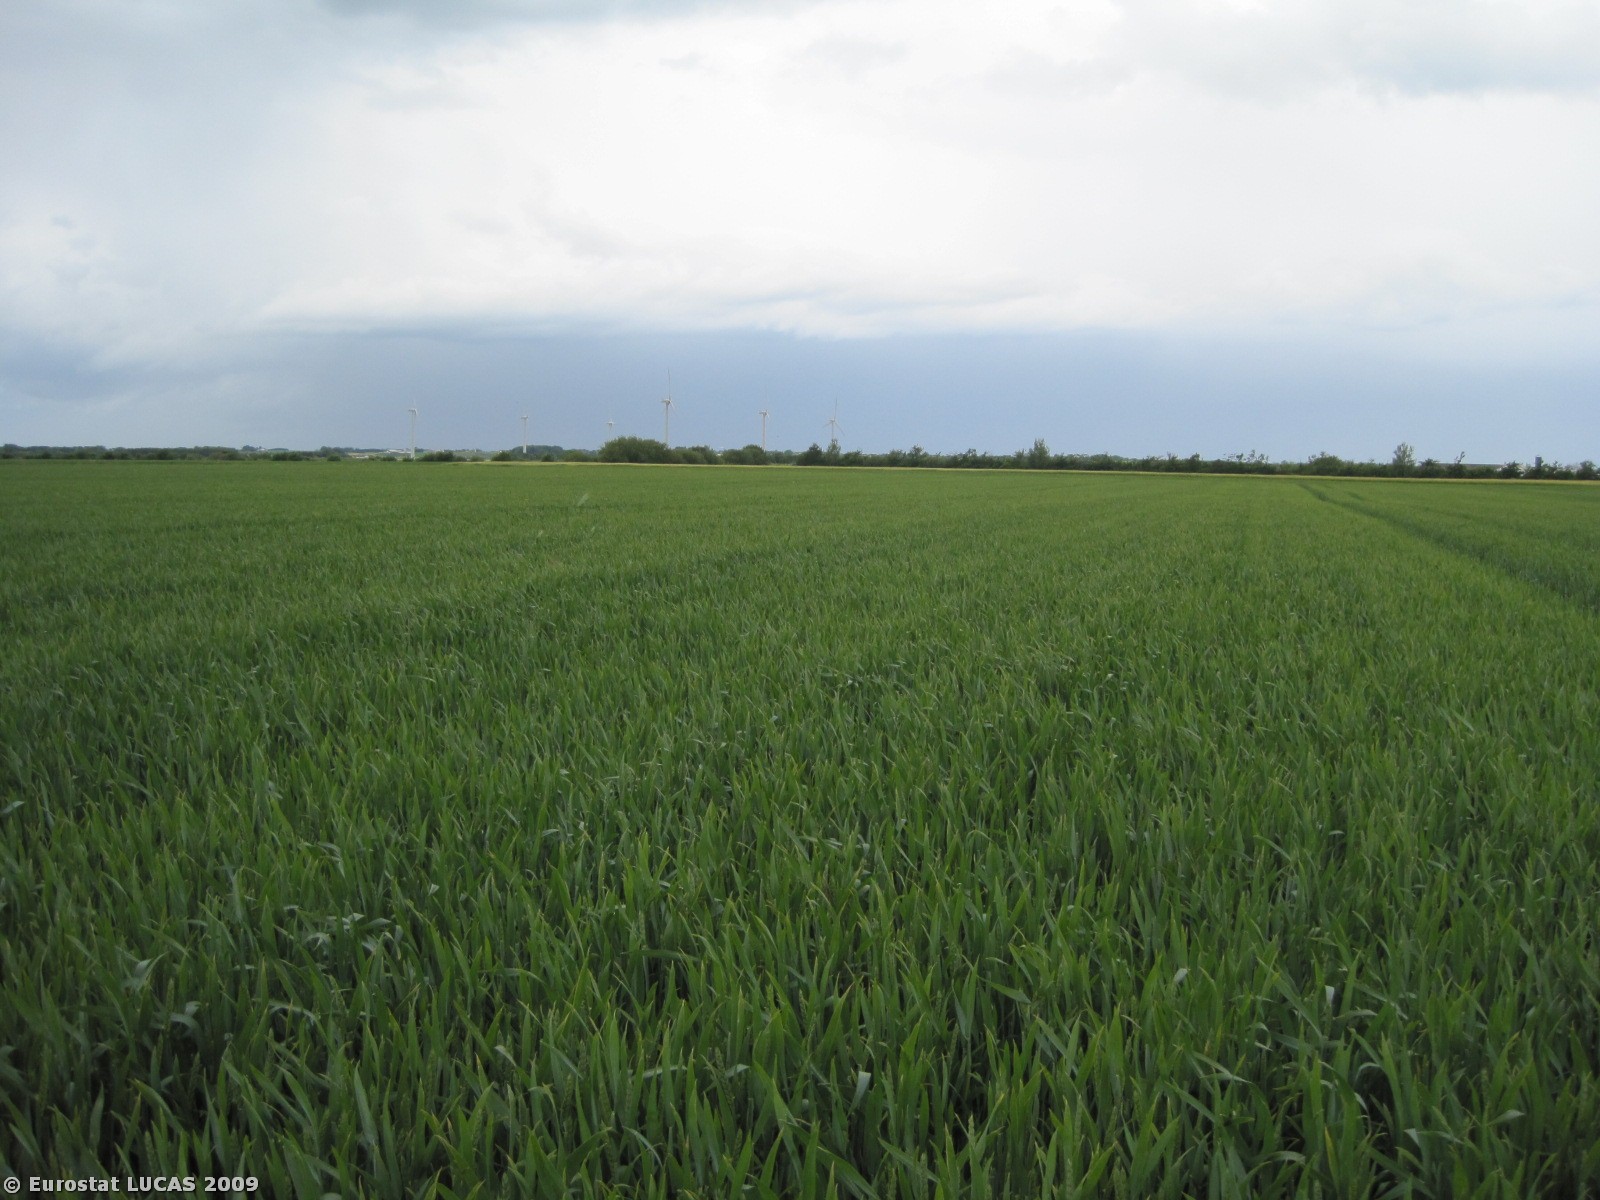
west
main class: Cropland
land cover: Common wheat
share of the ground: > 75 %
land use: Agriculture (excluding fallow land and kitchen gardens)
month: June
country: DK
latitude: 57.2662
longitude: 9.7848
